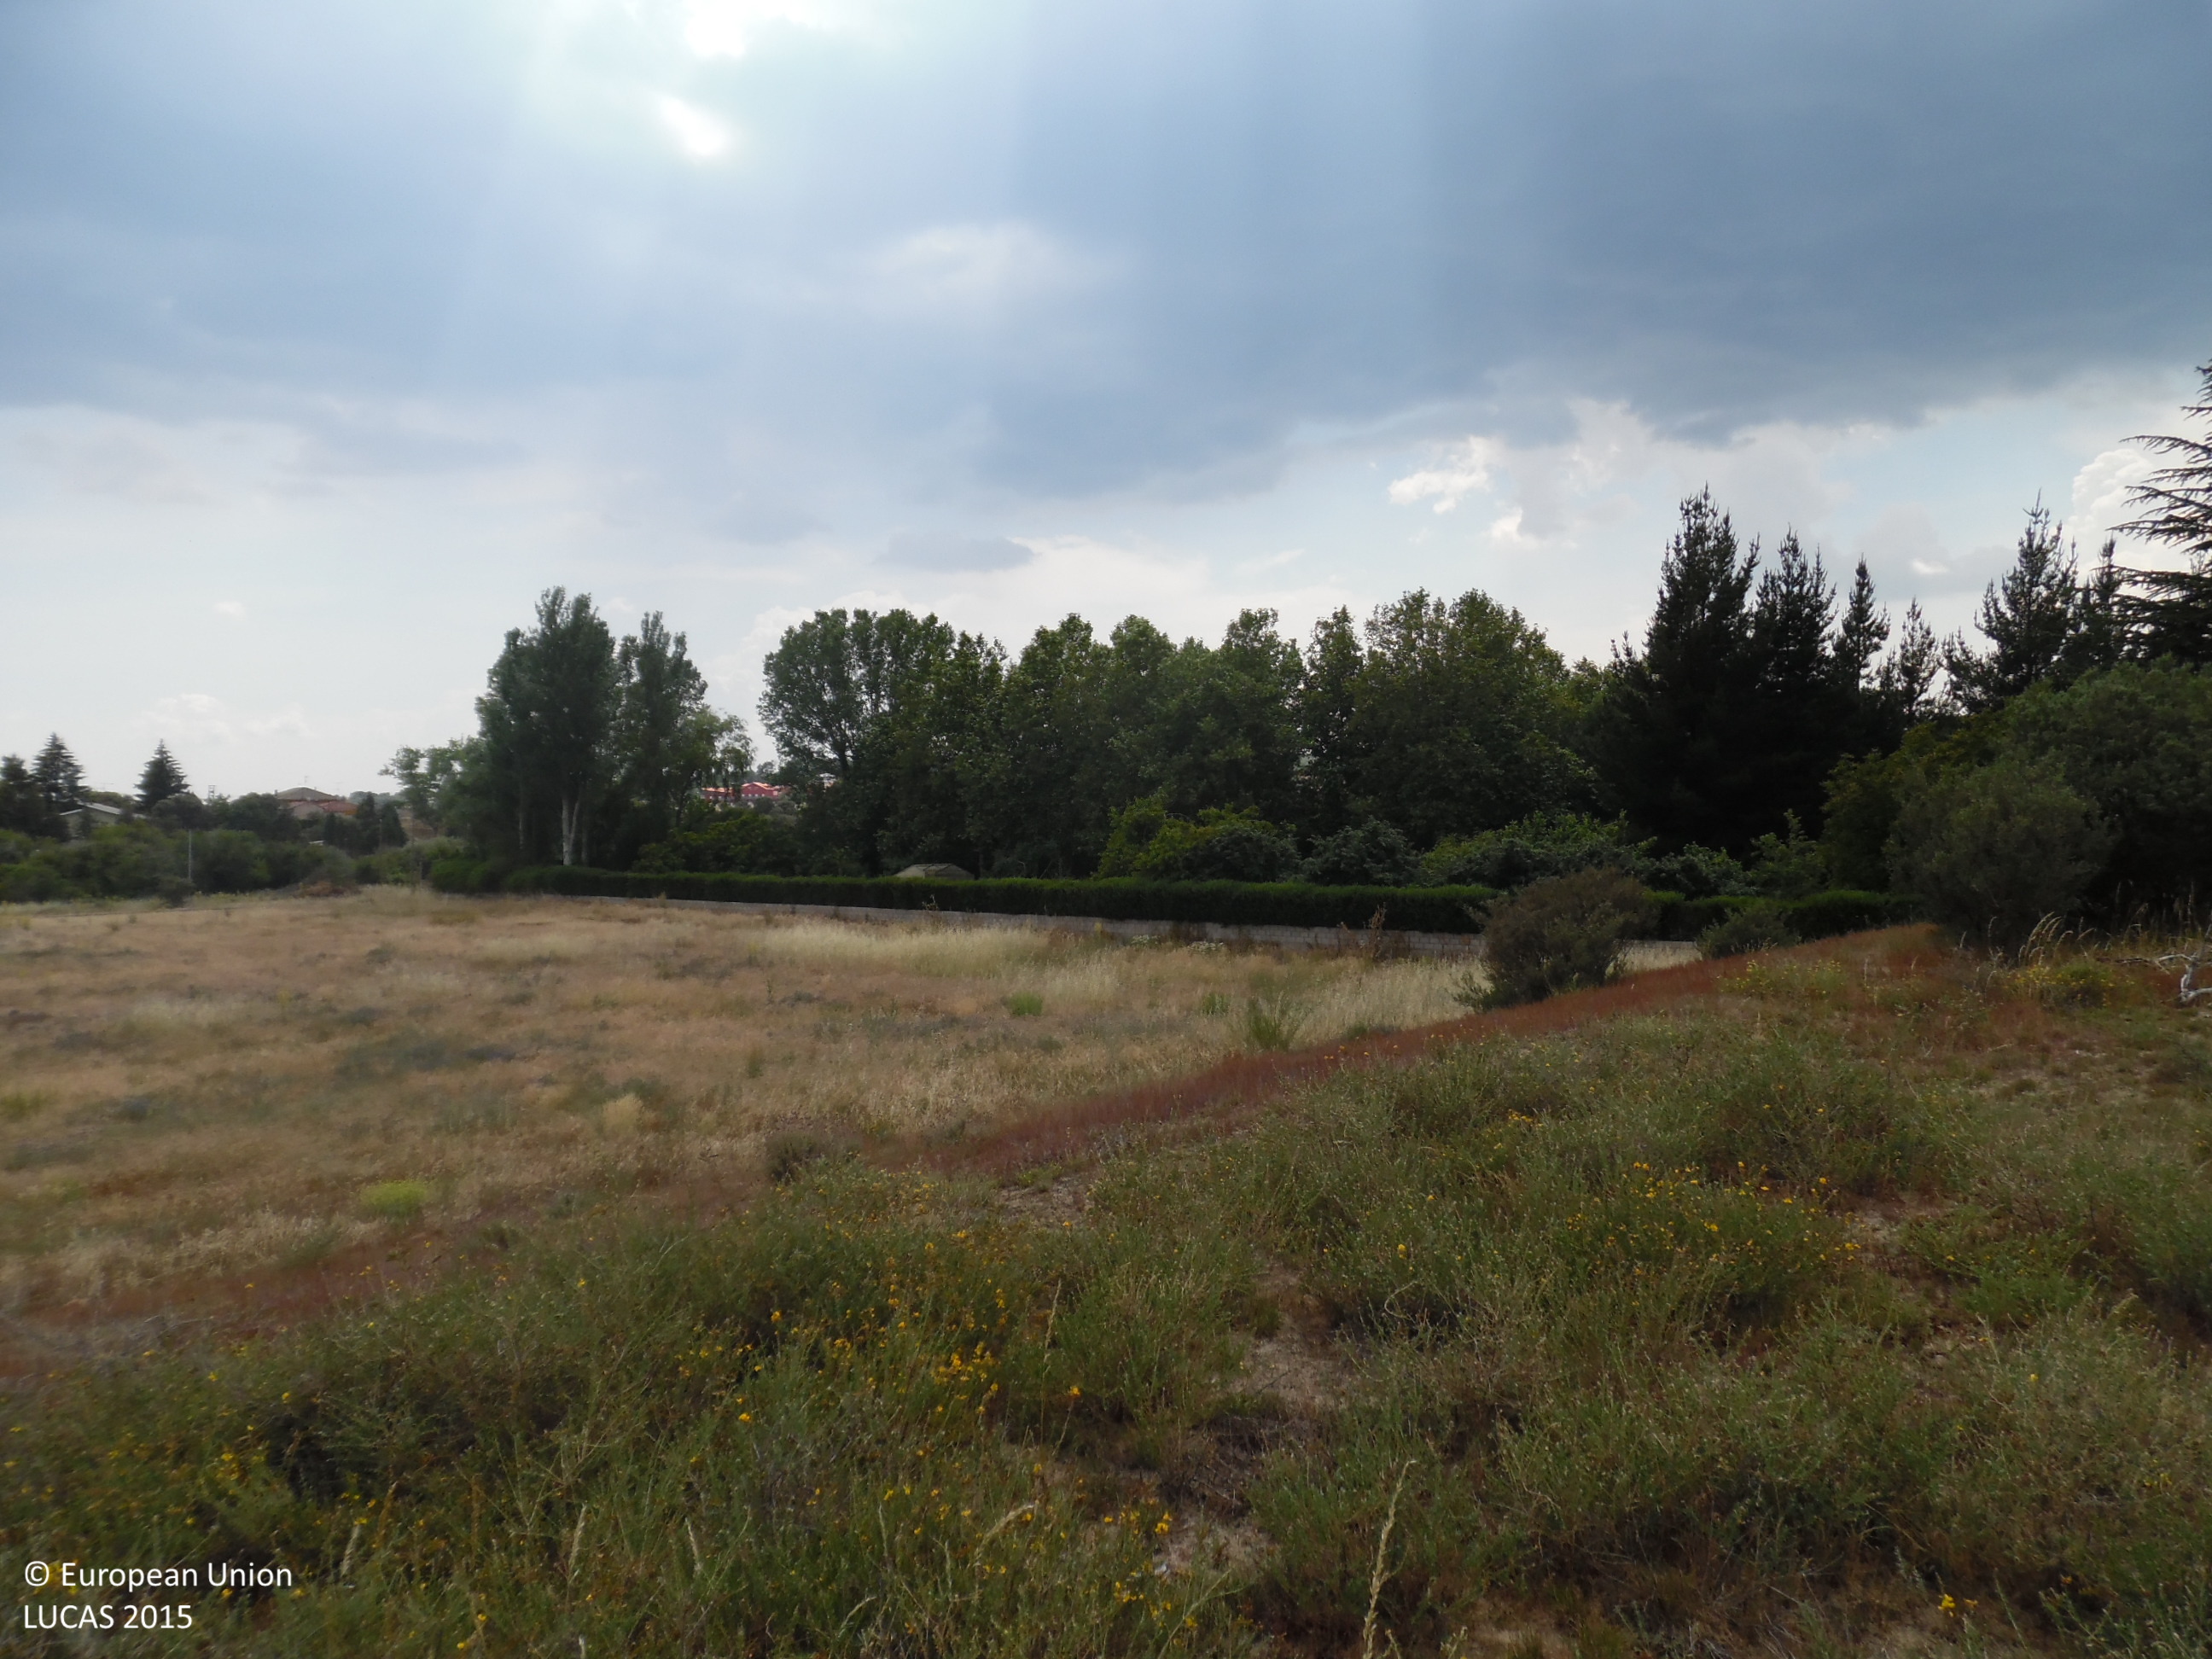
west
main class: Grassland
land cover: Grassland with sparse tree/shrub cover
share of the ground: > 75 %
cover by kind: herbaceous plants 95 %, broadleaved forest trees 5 %
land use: Agriculture (excluding fallow land and kitchen gardens)
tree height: < 5 m
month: June
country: ES
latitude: 42.6795
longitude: -5.6345
